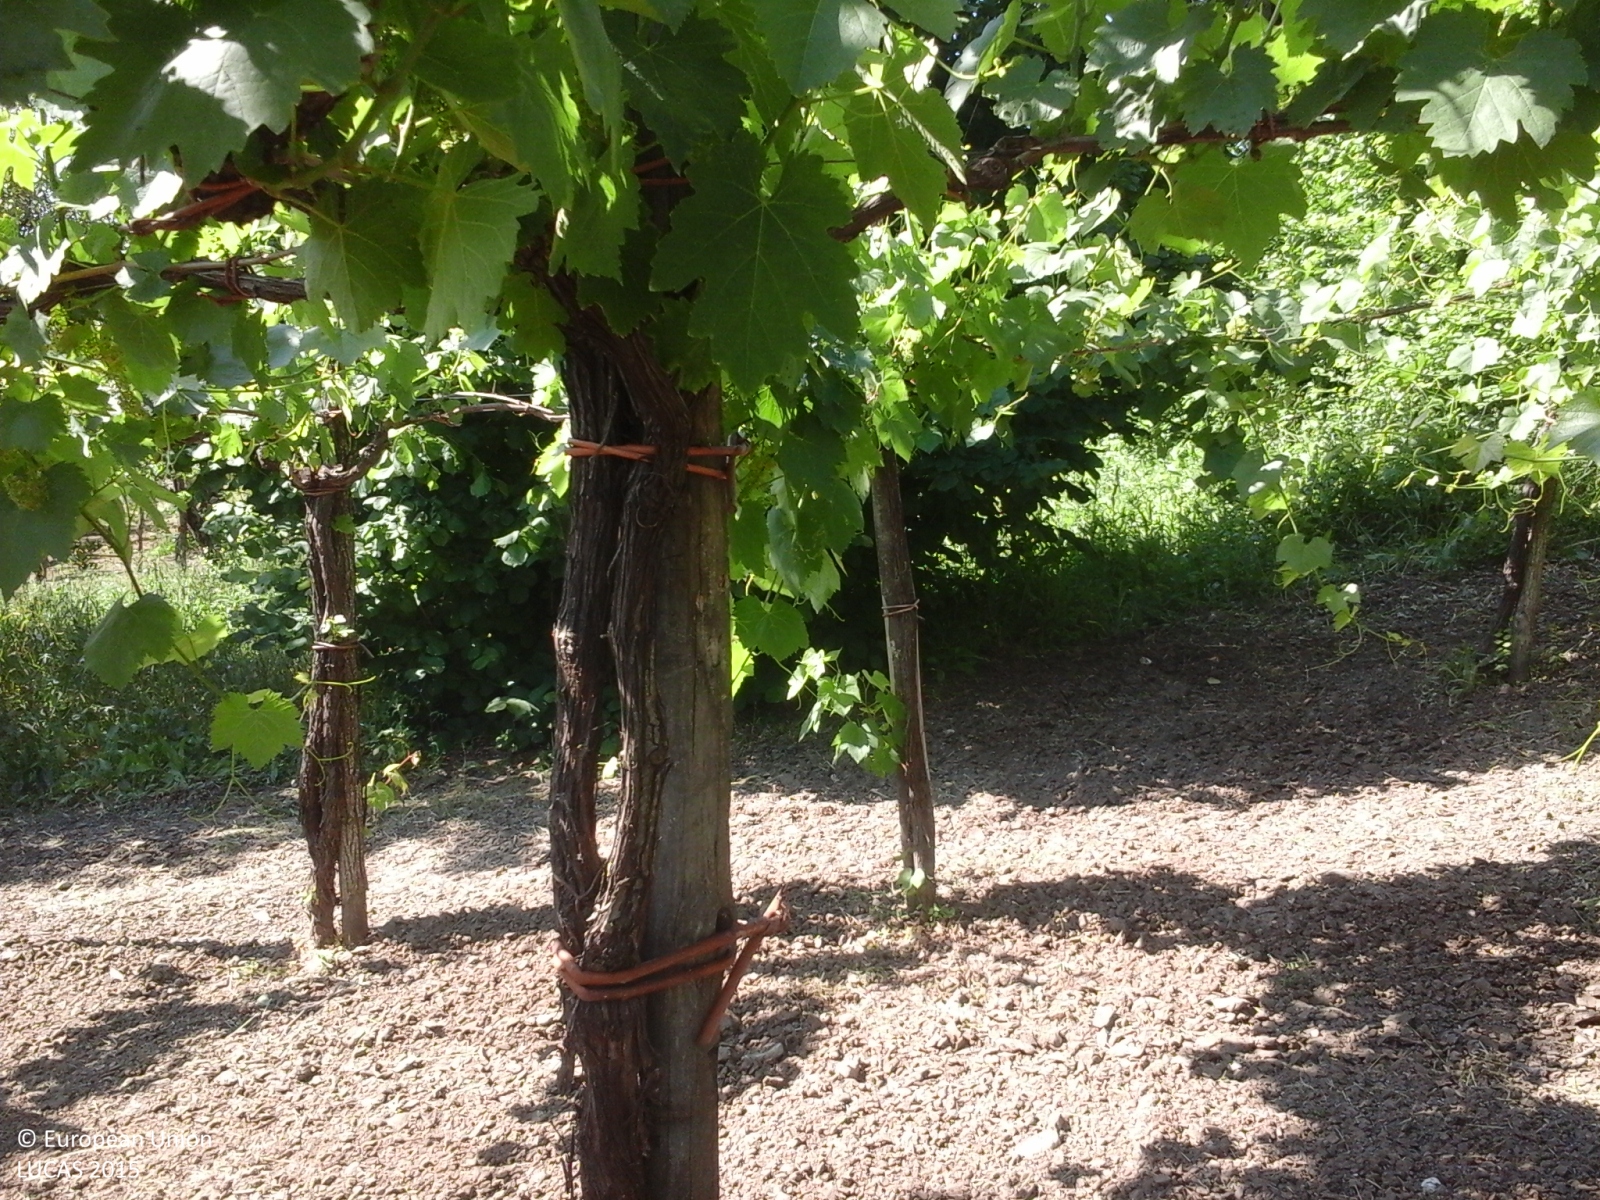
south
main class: Cropland
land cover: Vineyards
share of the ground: > 75 %
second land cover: Other bare soil
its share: > 75 %
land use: Agriculture (excluding fallow land and kitchen gardens)
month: June
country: IT
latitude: 41.1698
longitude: 14.6903
